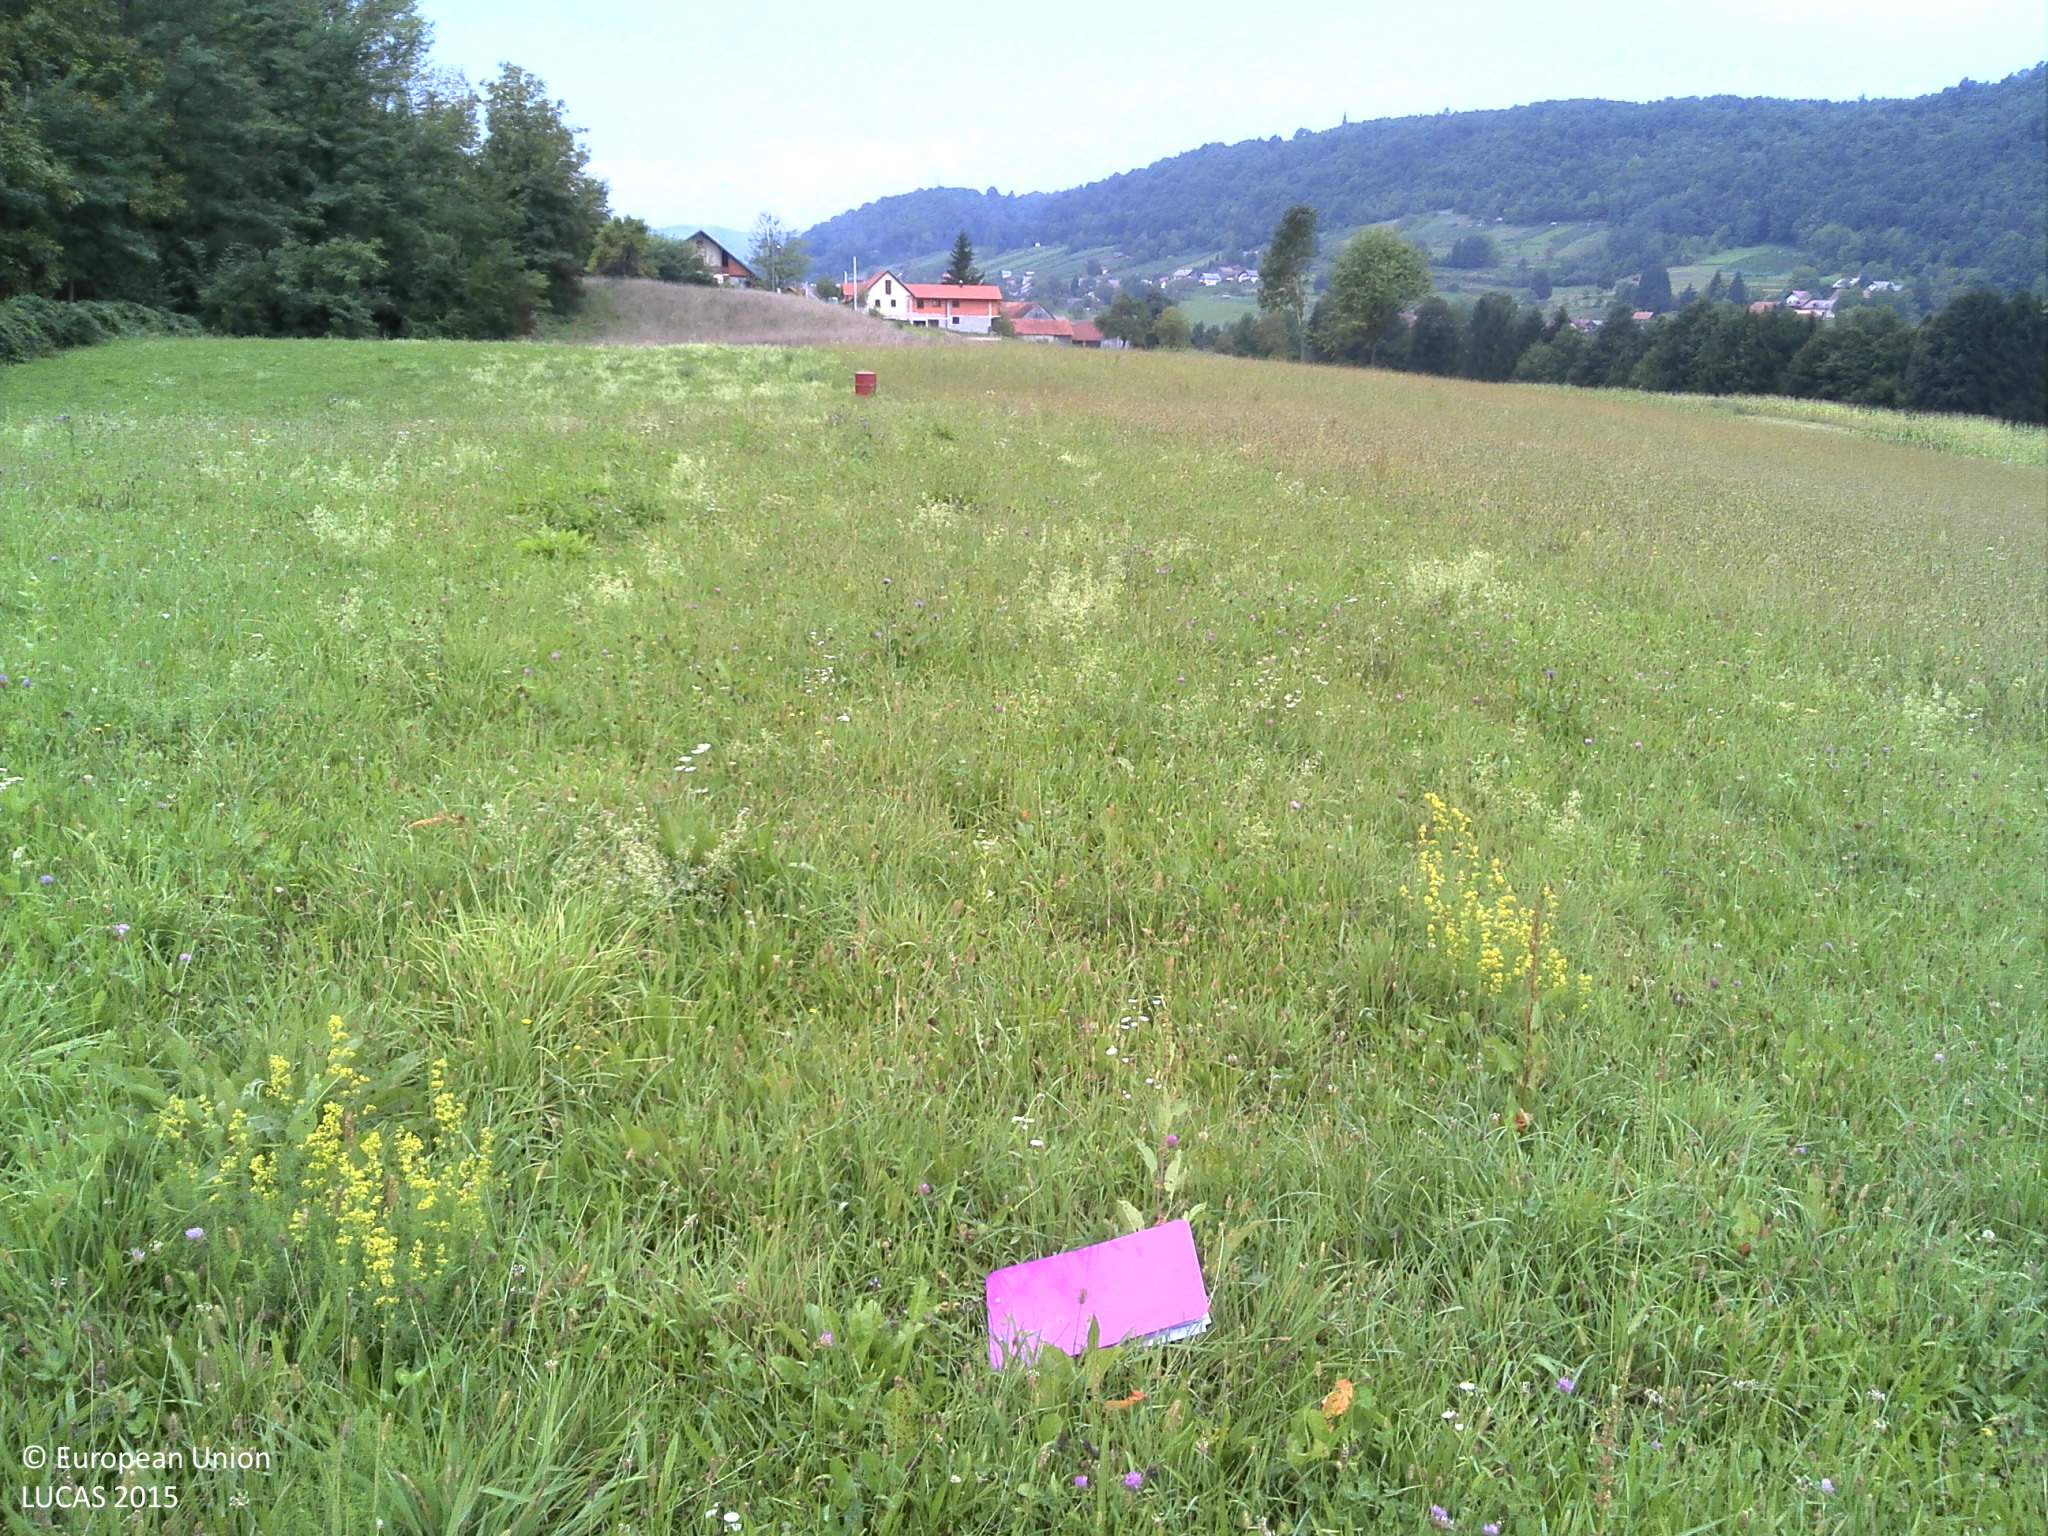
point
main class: Cropland
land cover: Clovers
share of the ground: > 75 %
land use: Agriculture (excluding fallow land and kitchen gardens)
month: September
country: HR
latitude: 45.4627
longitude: 15.2778
